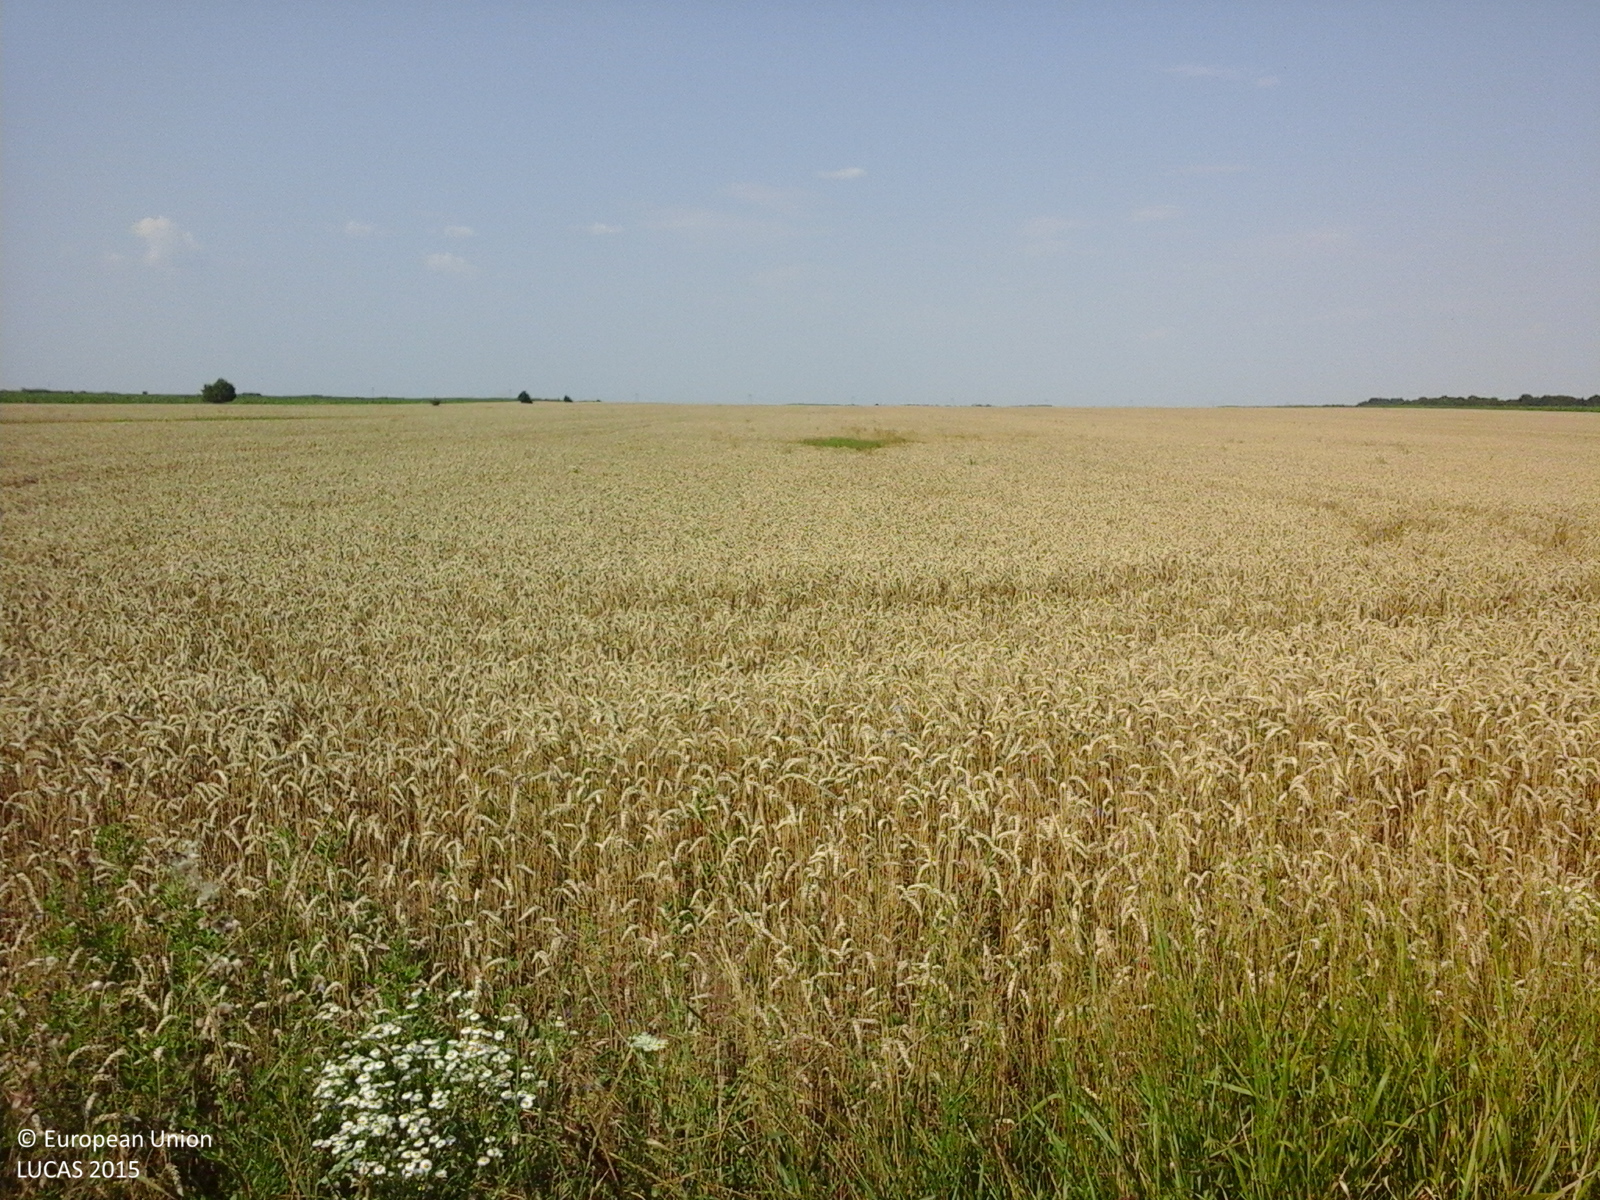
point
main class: Cropland
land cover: Common wheat
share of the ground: > 75 %
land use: Agriculture (excluding fallow land and kitchen gardens)
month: July
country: RO
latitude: 44.5749
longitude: 24.9790
